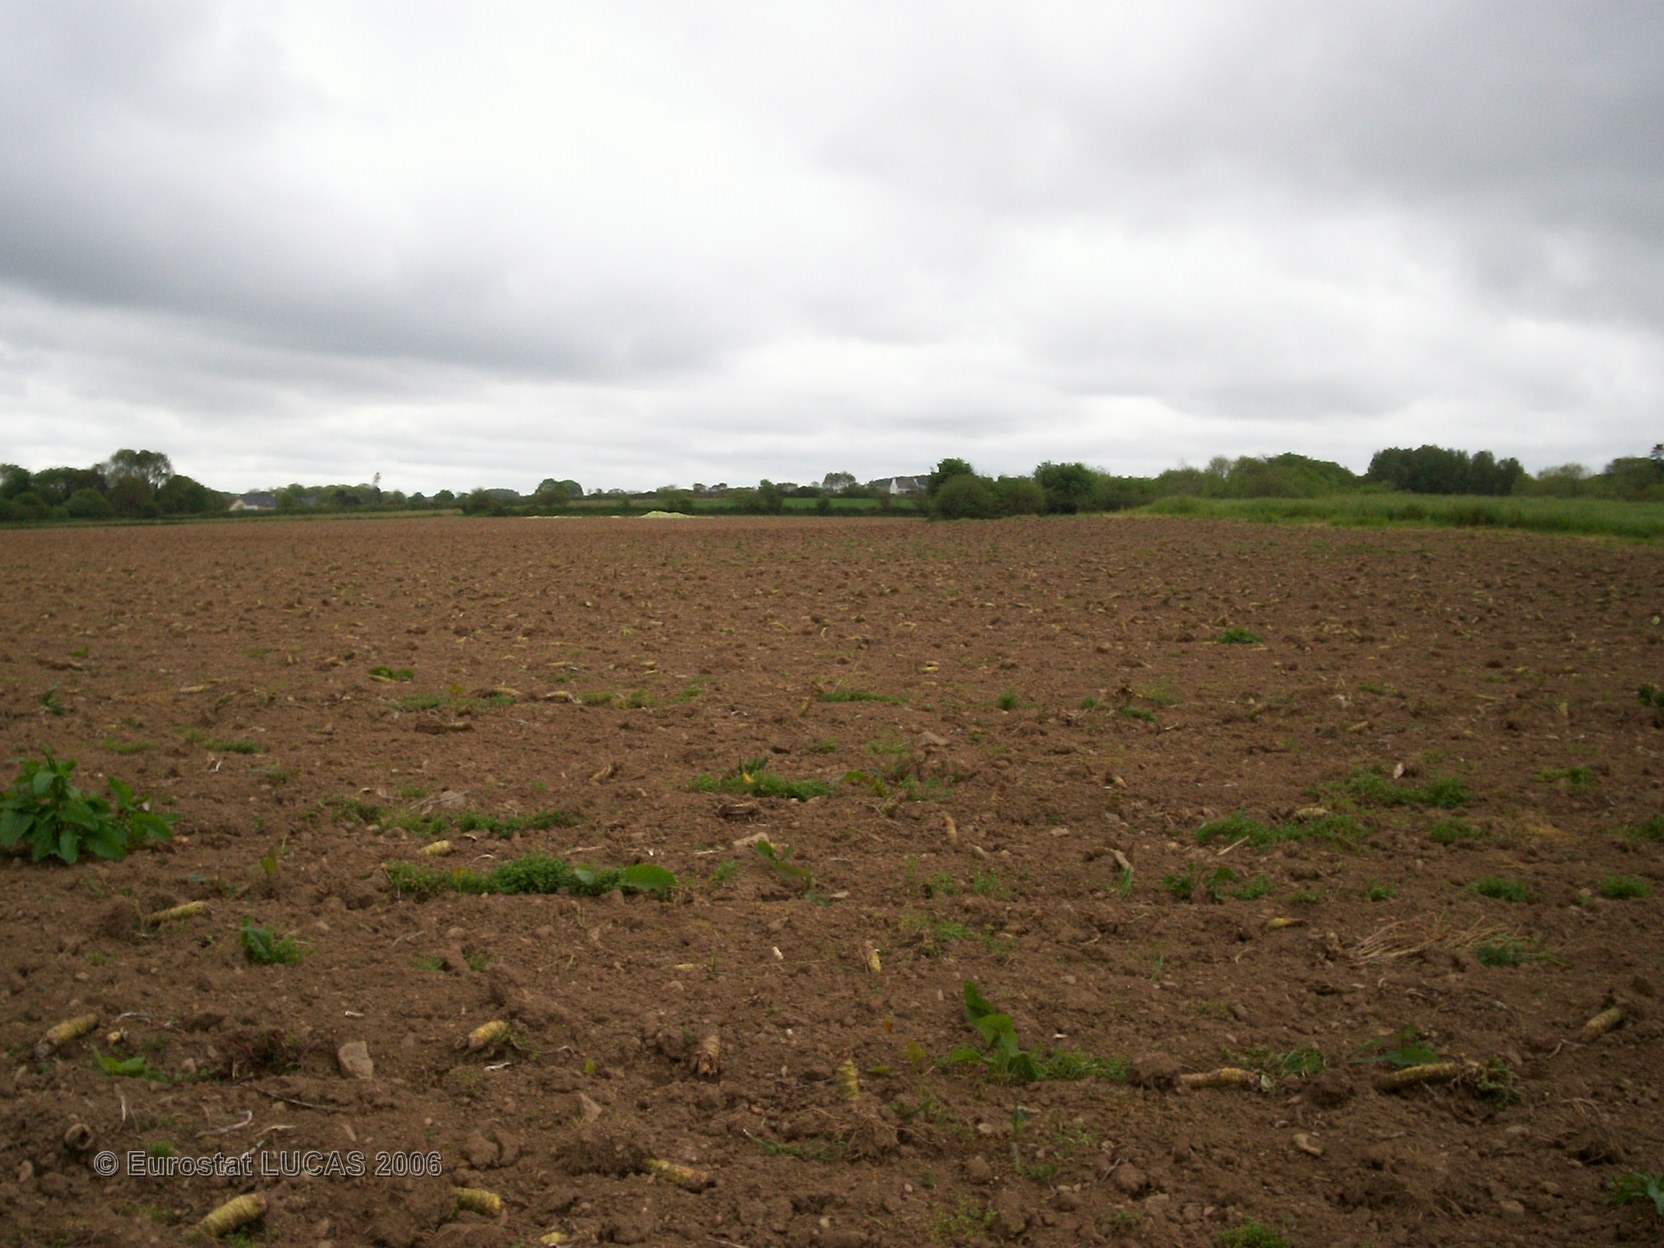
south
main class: Bare land
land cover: Bare land
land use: Agriculture (excluding fallow land and kitchen gardens)
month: May
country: FR
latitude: 48.6588
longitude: -3.7003
